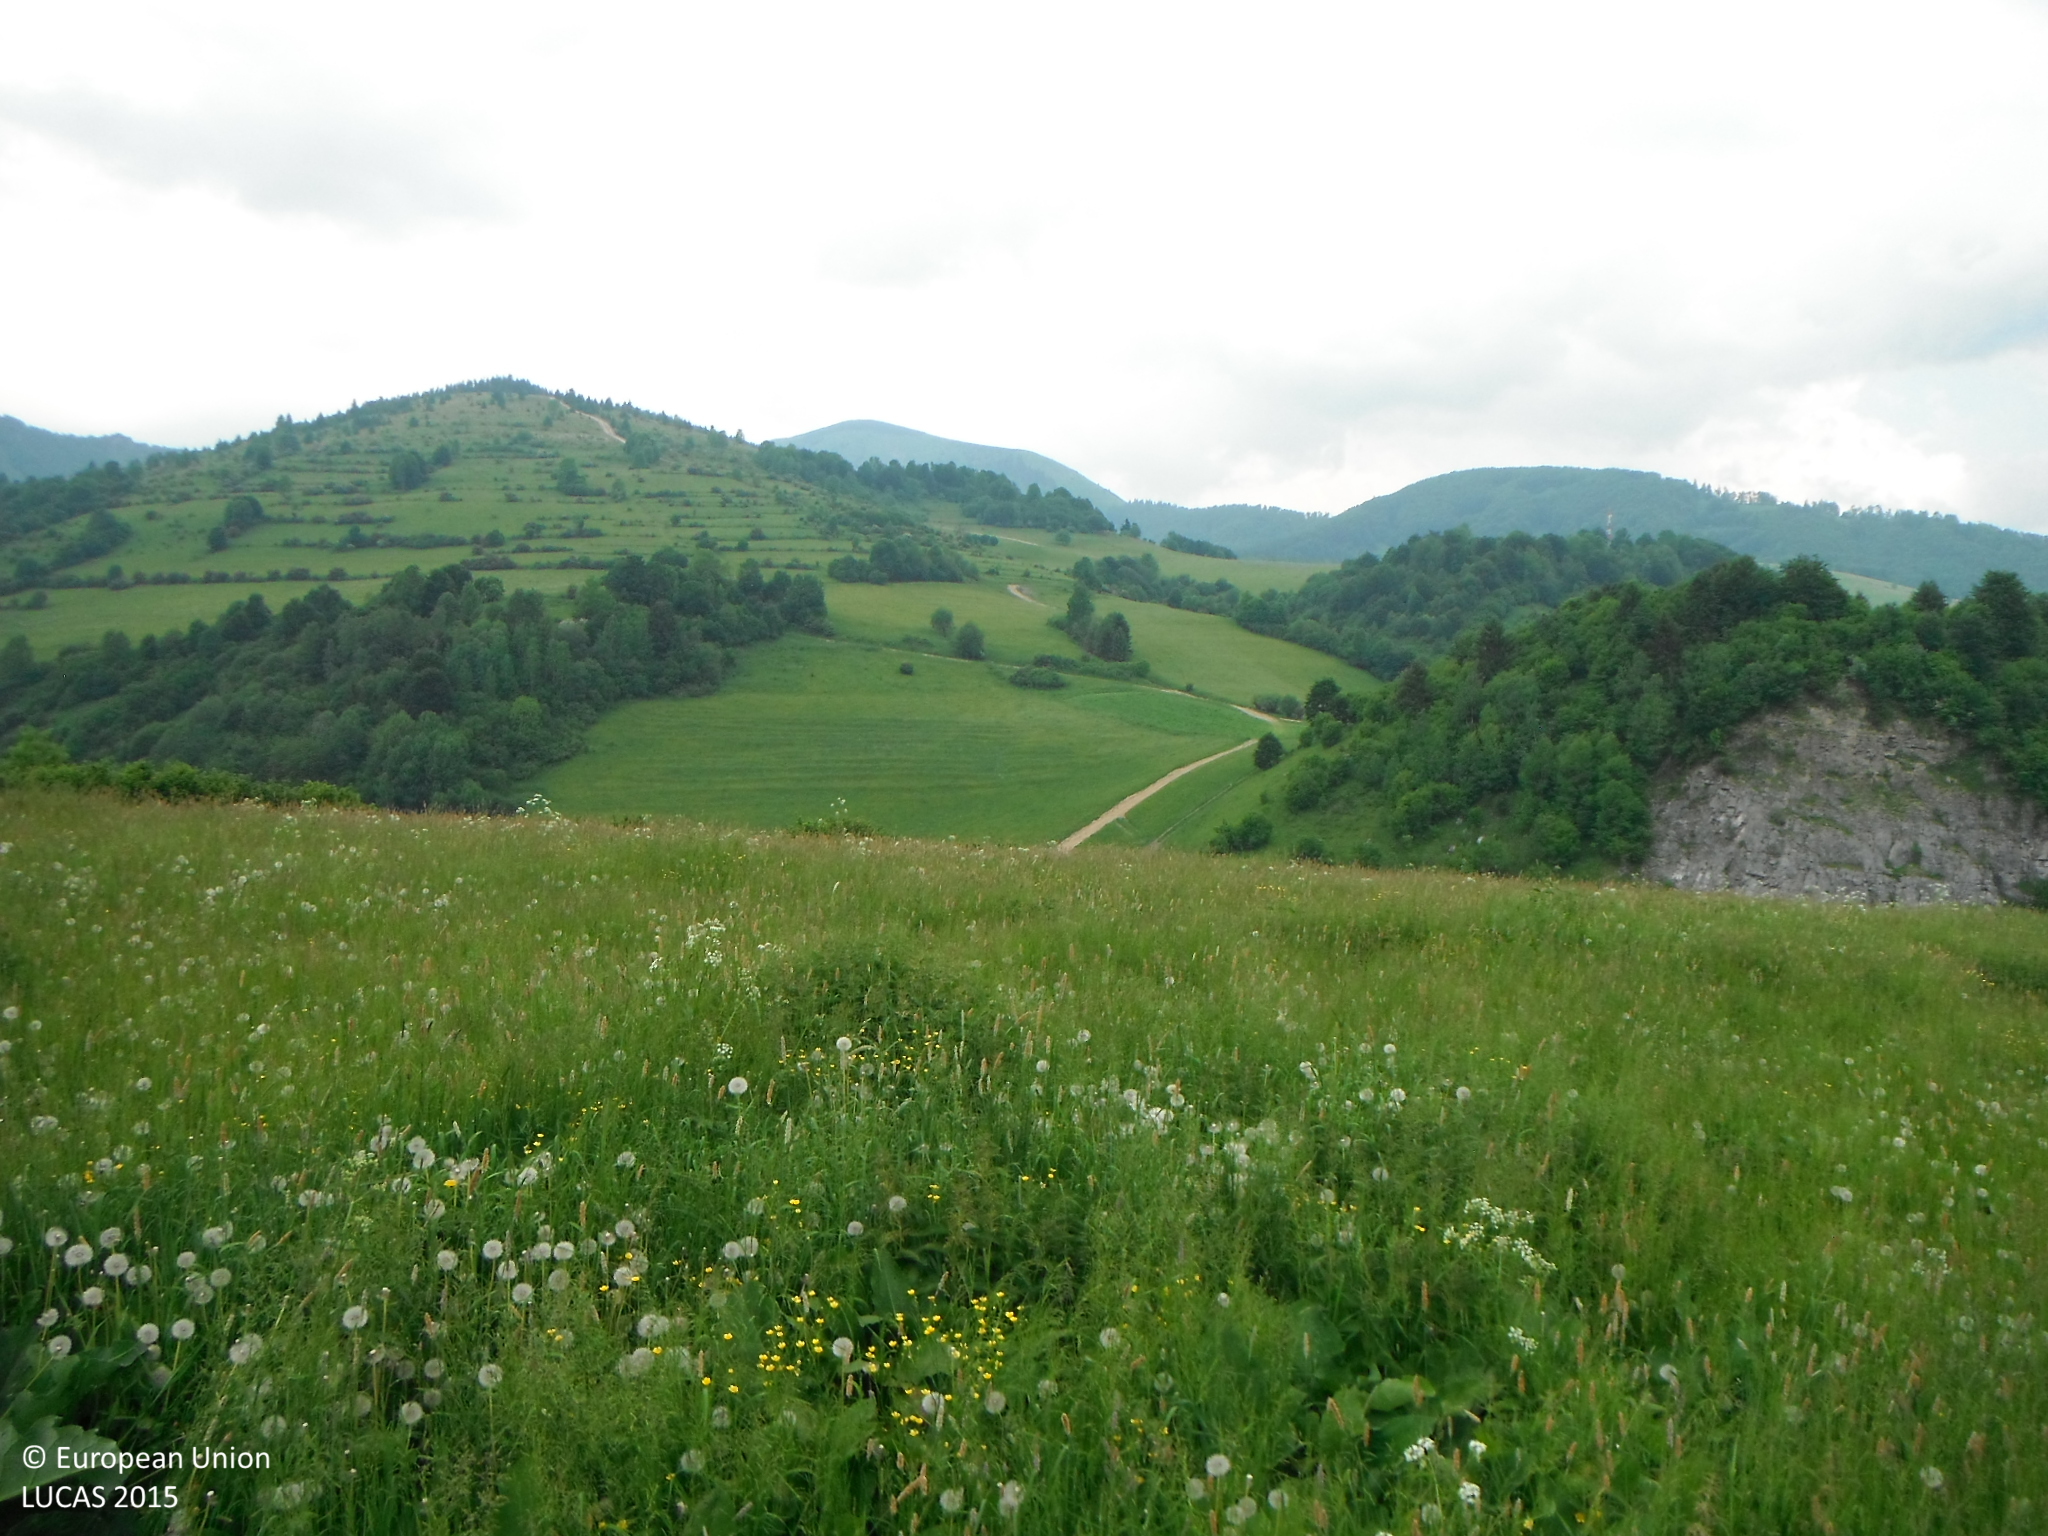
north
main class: Grassland
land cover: Grassland without tree/shrub cover
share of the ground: > 75 %
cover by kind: herbaceous plants 100 %
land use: Agriculture (excluding fallow land and kitchen gardens)
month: June
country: SK
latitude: 48.9261
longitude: 19.1812
